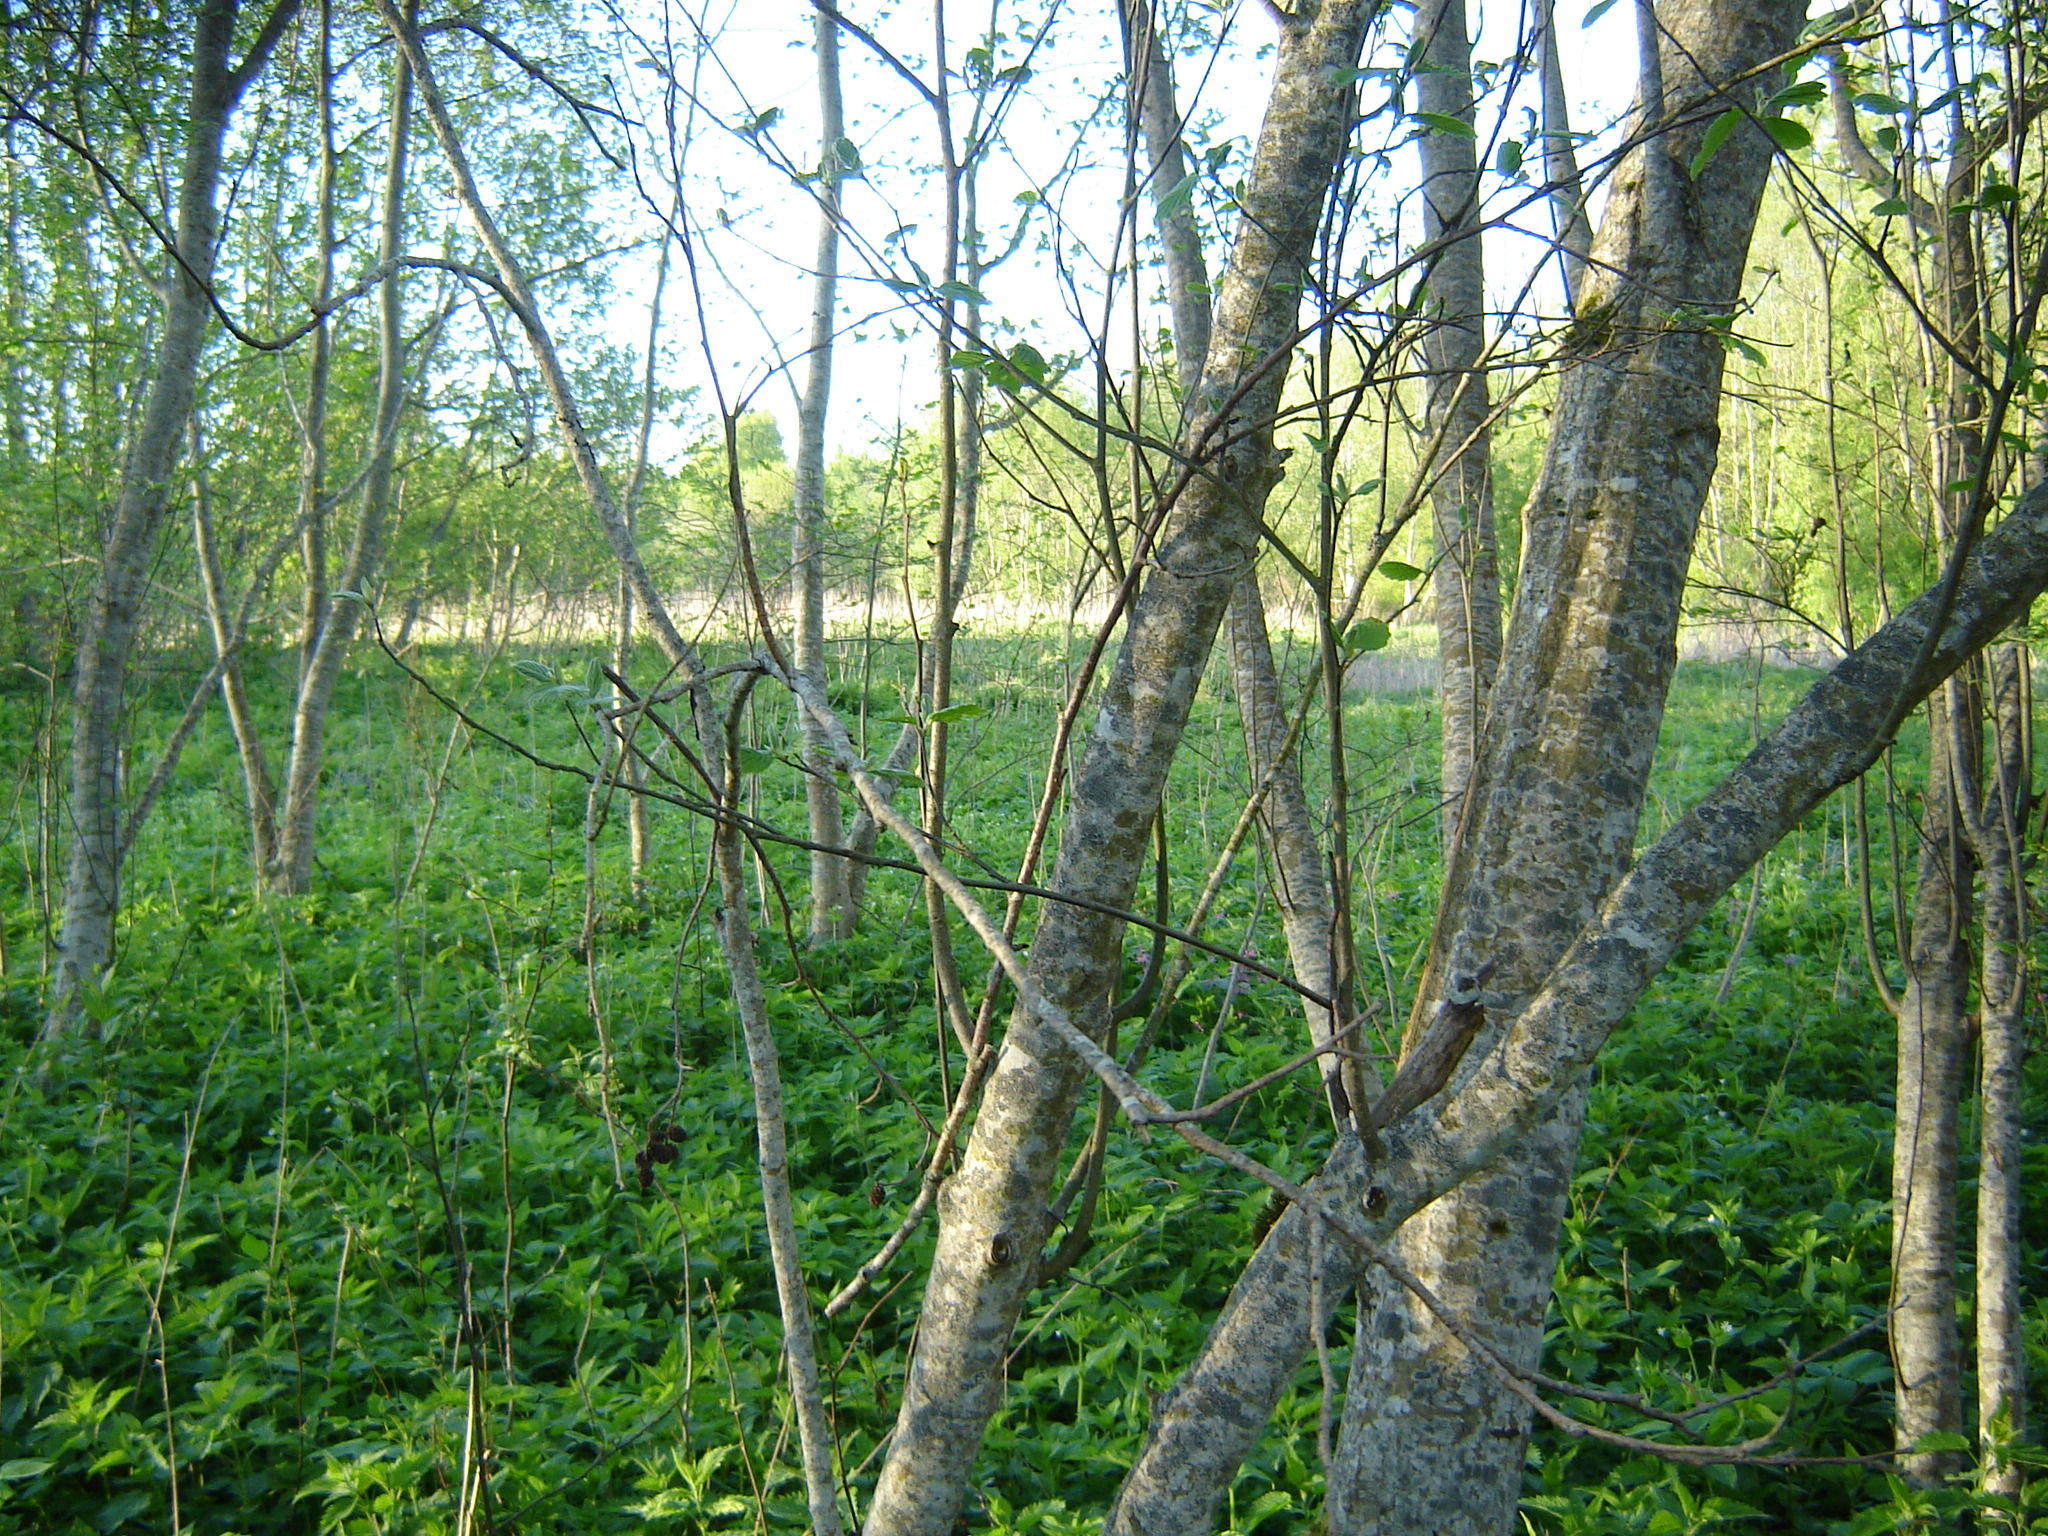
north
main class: Woodland
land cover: Broadleaved woodland
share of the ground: > 75 %
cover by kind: broadleaved forest trees 80 %, herbaceous plants 20 %
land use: Forestry
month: May
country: LT
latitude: 56.0734
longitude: 25.2656
